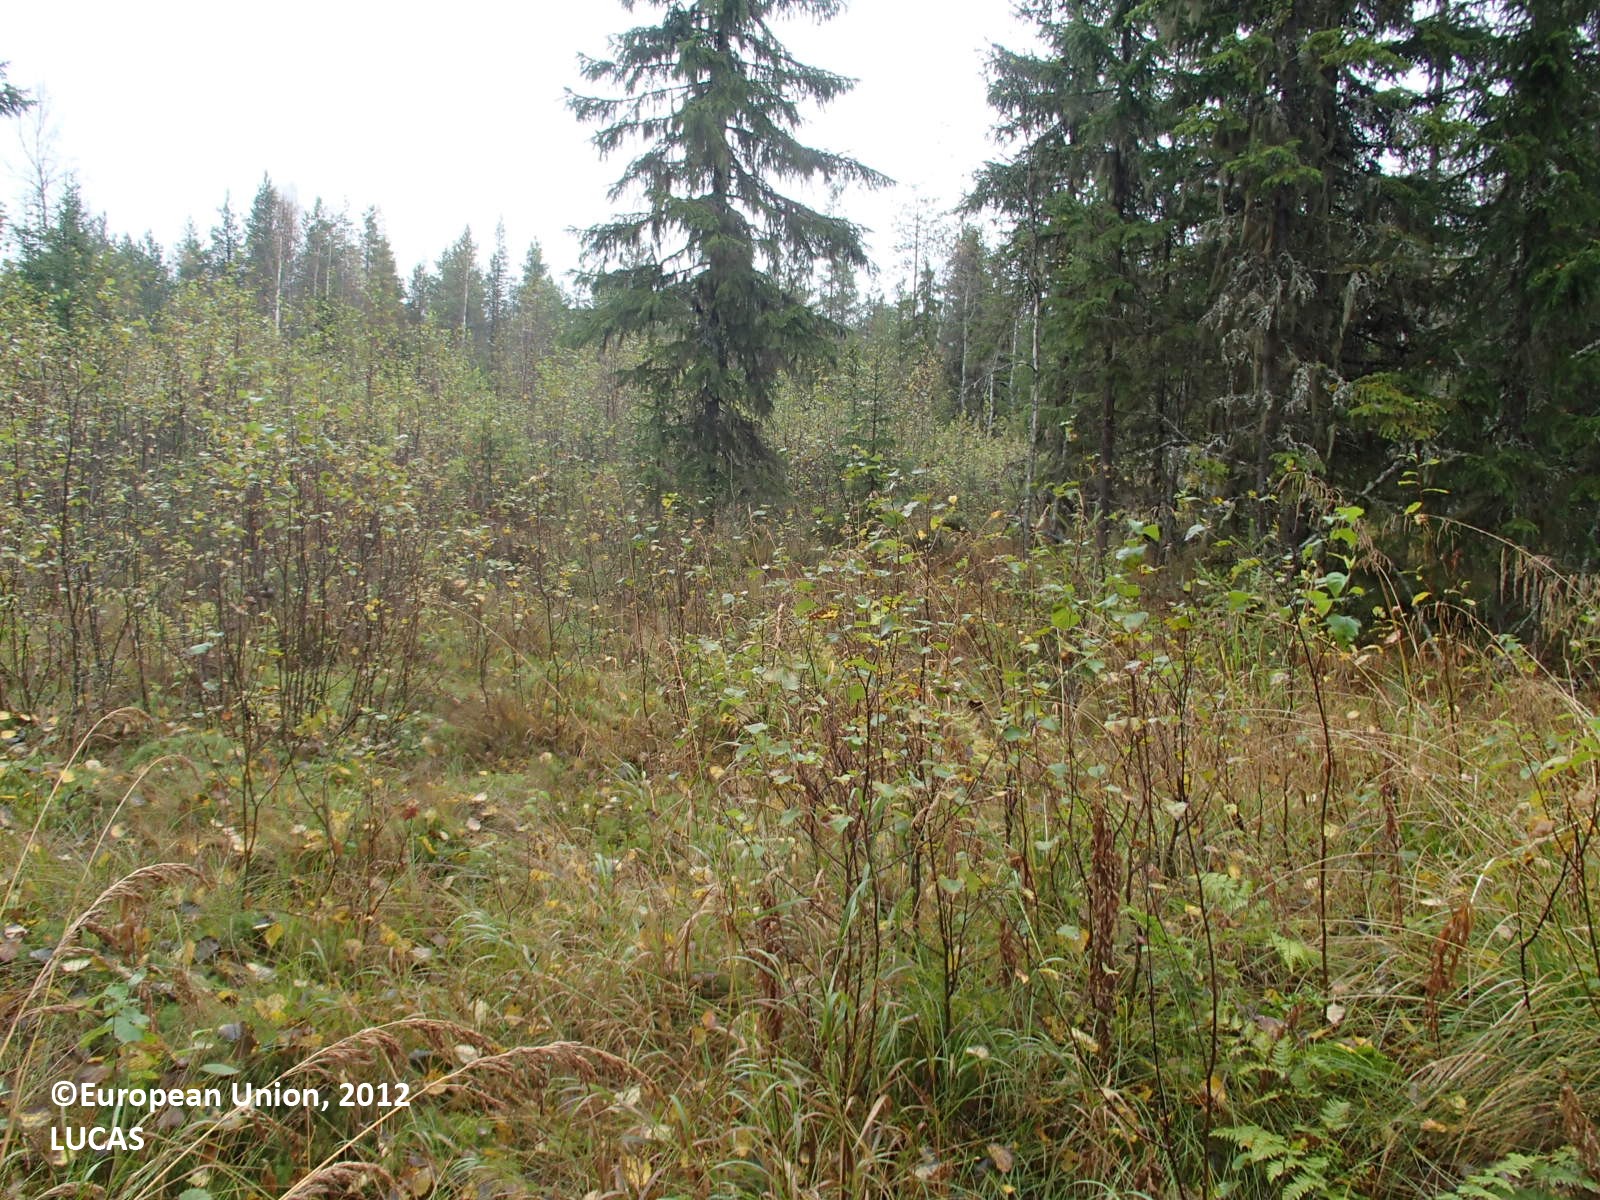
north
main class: Grassland
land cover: Spontaneously vegetated surfaces
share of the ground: > 75 %
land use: Fallow land
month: September
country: FI
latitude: 63.8249
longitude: 26.8132
